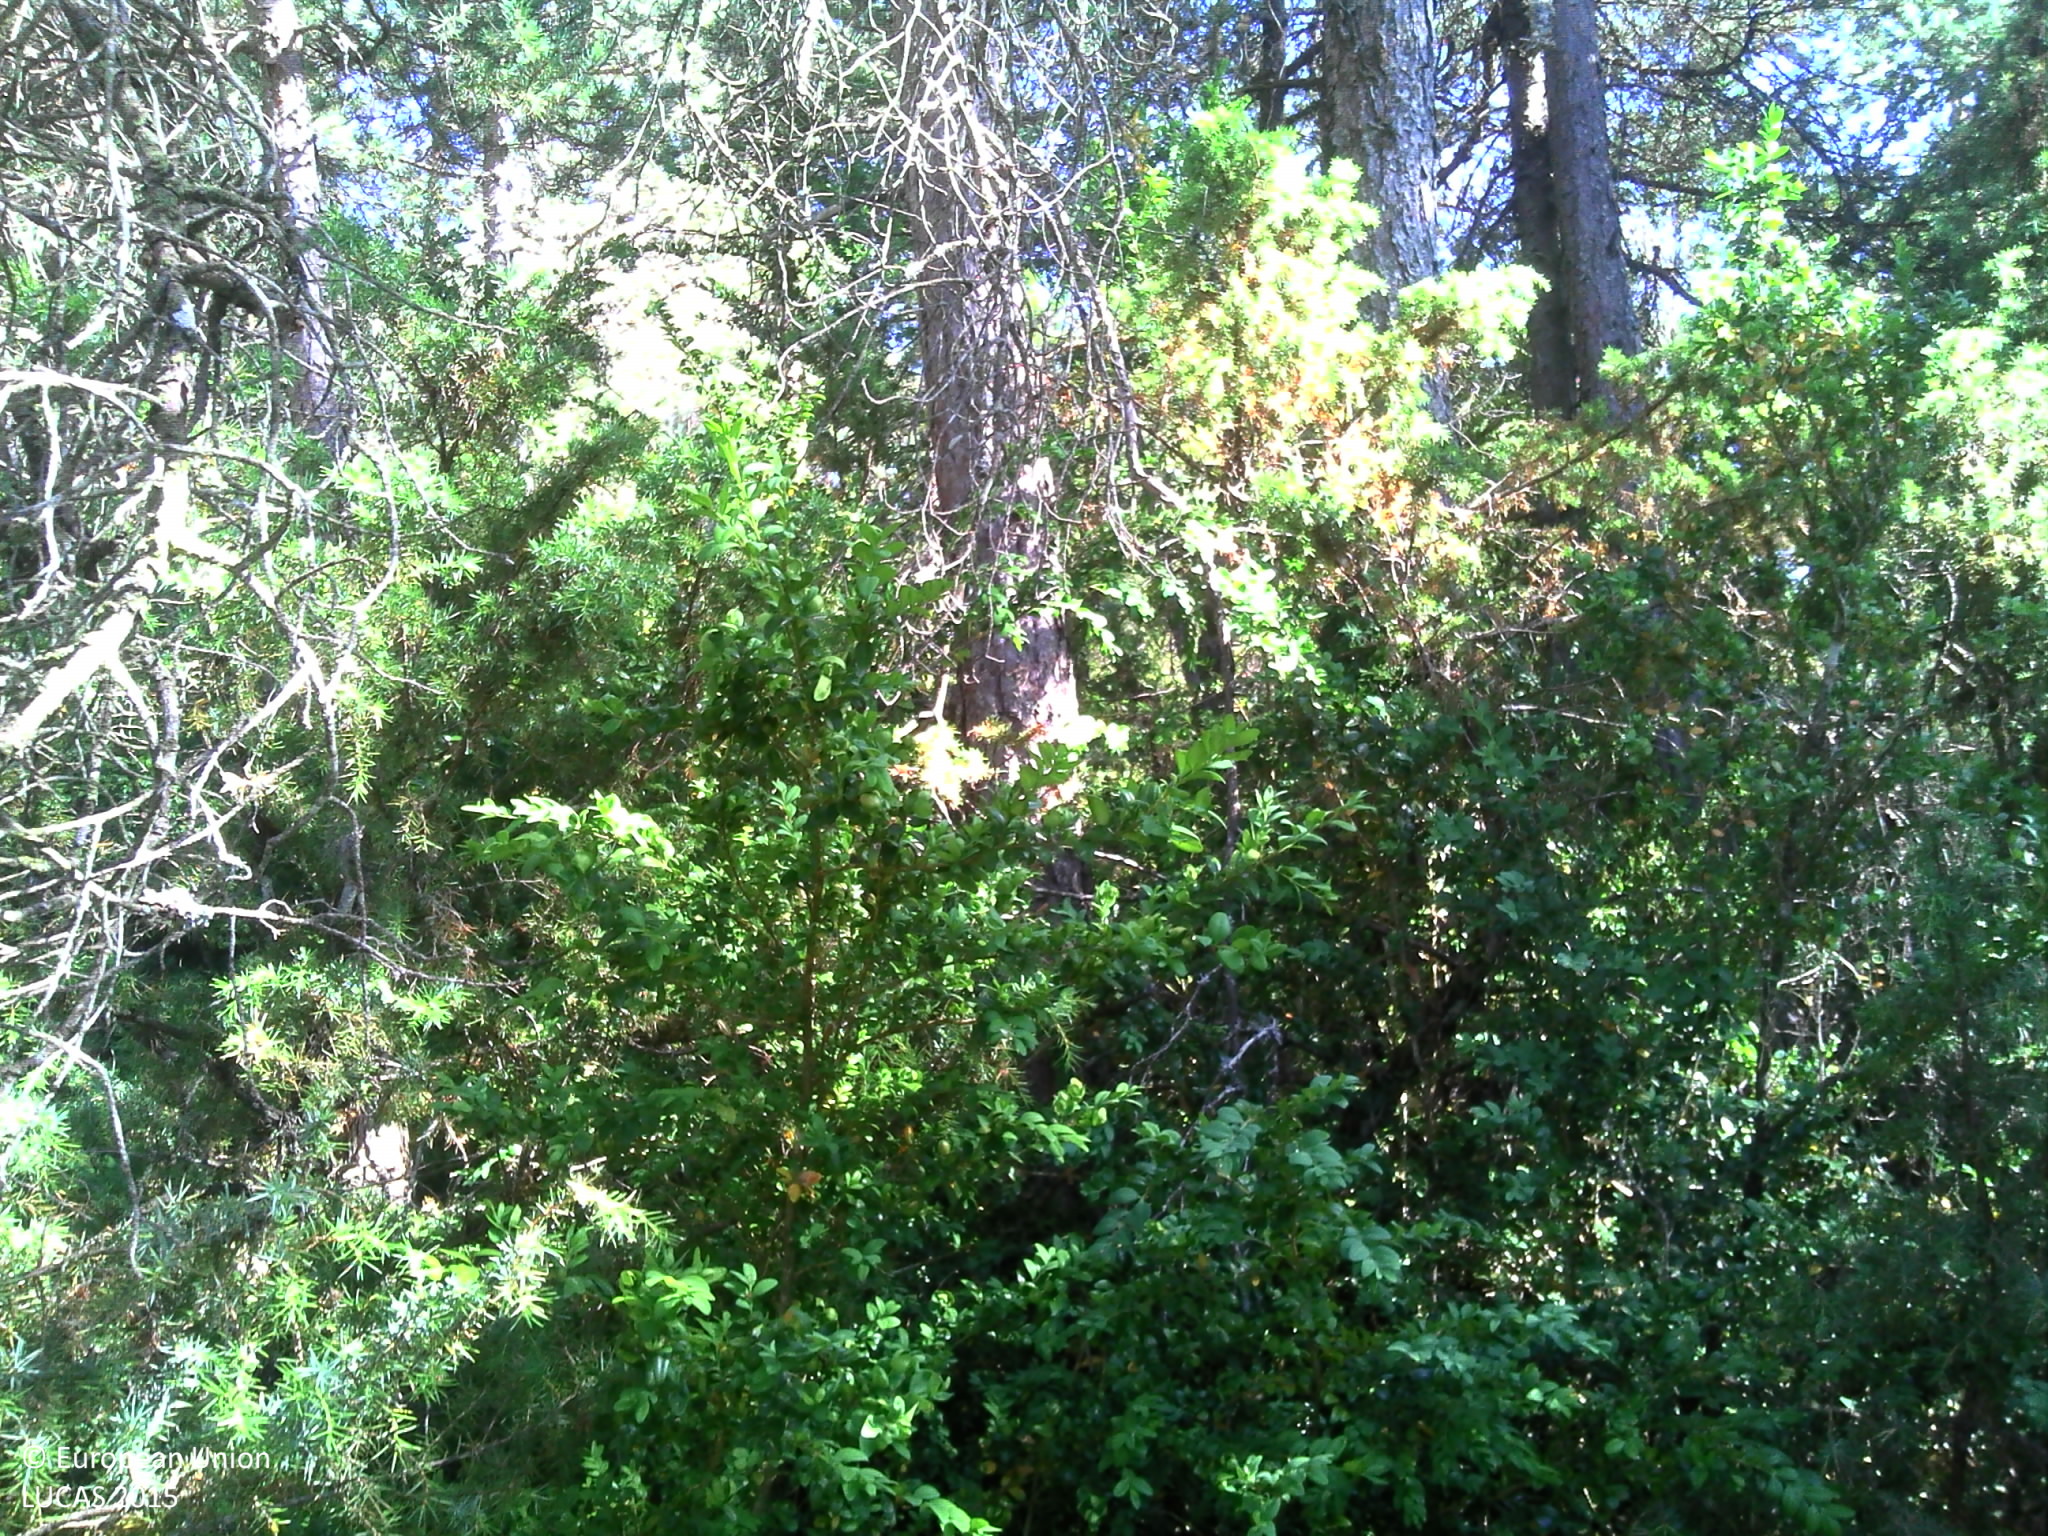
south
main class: Woodland
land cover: Pine dominated coniferous woodland
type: alpine coniferous forest
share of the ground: > 75 %
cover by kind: coniferous forest trees 75 %, shrubs 10 %, herbaceous plants 10 %, broadleaved forest trees 5 %
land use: Forestry
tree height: > 5 m
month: July
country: FR
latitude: 44.3670
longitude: 3.2667
